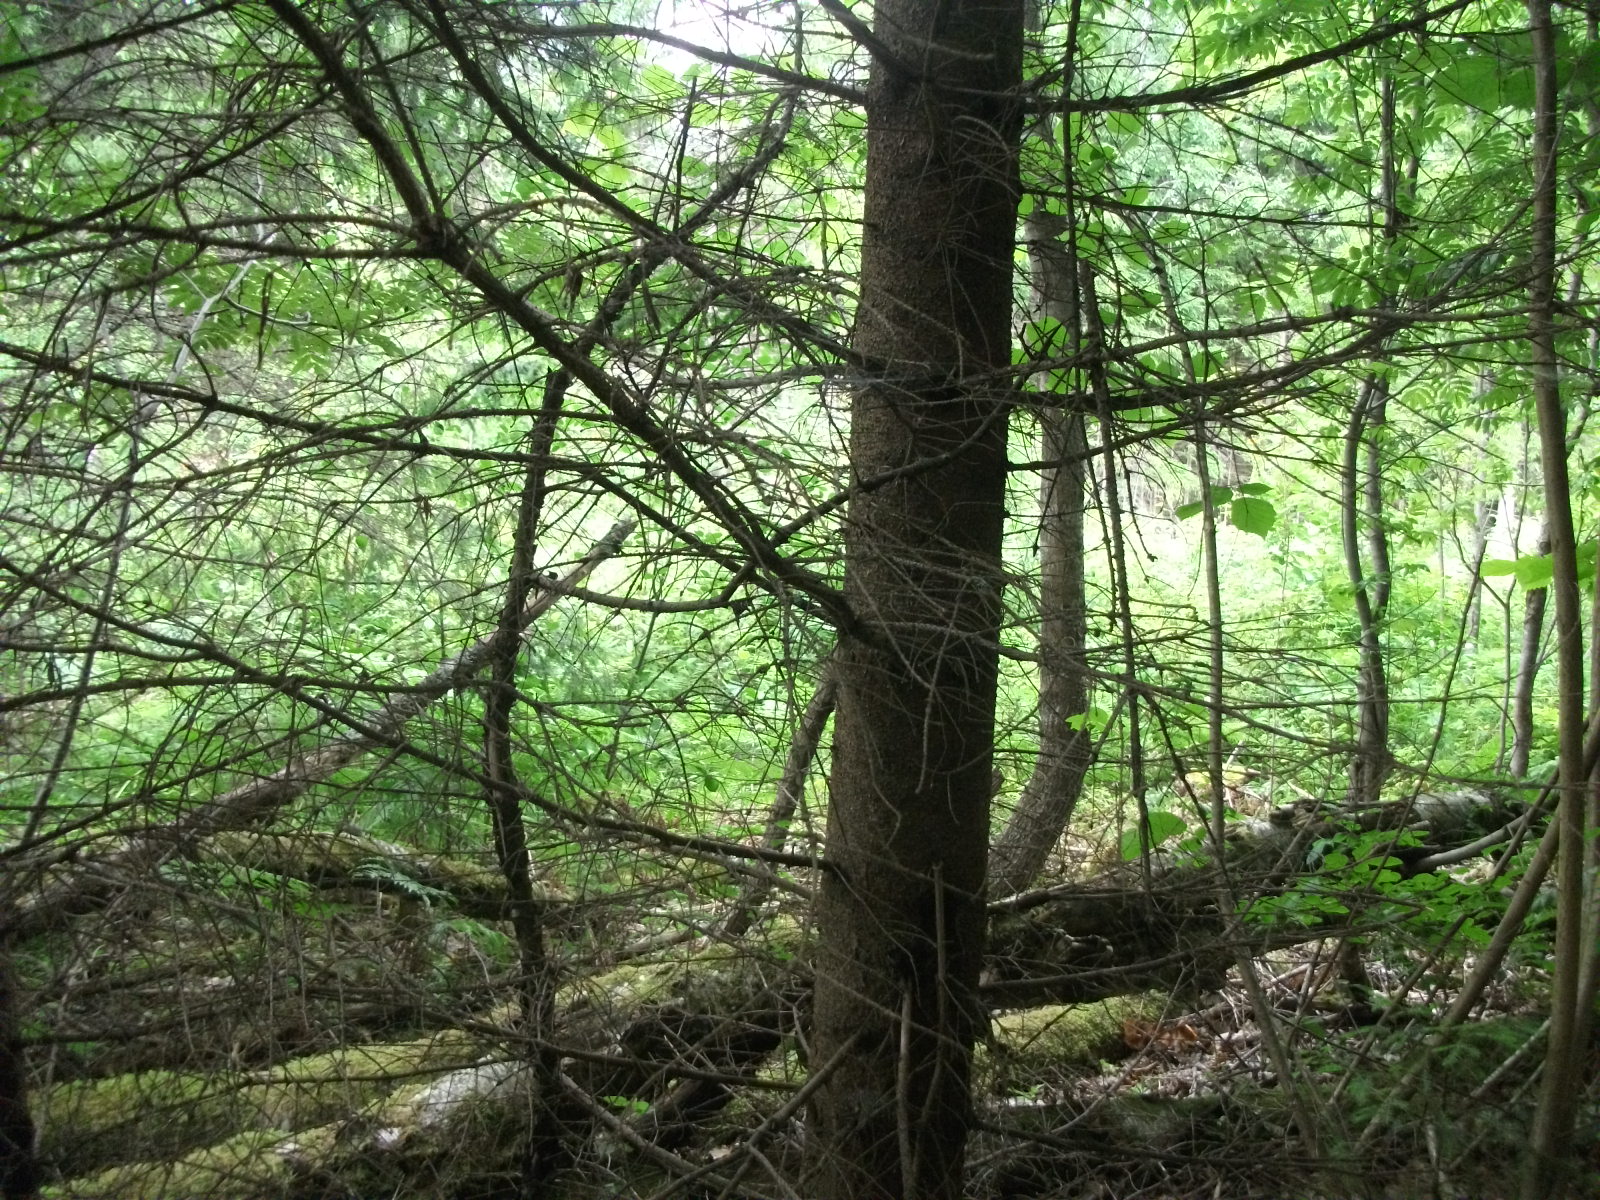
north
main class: Woodland
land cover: Spruce dominated coniferous woodland
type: hemiboreal forest and nemoral coniferous forest and mixed broadleaved-coniferous forest
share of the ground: > 75 %
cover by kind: coniferous forest trees 90 %, herbaceous plants 5 %, unconsolidated bare surface 5 %
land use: Forestry
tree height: > 5 m
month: July
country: LV
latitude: 57.1833
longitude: 26.5408
